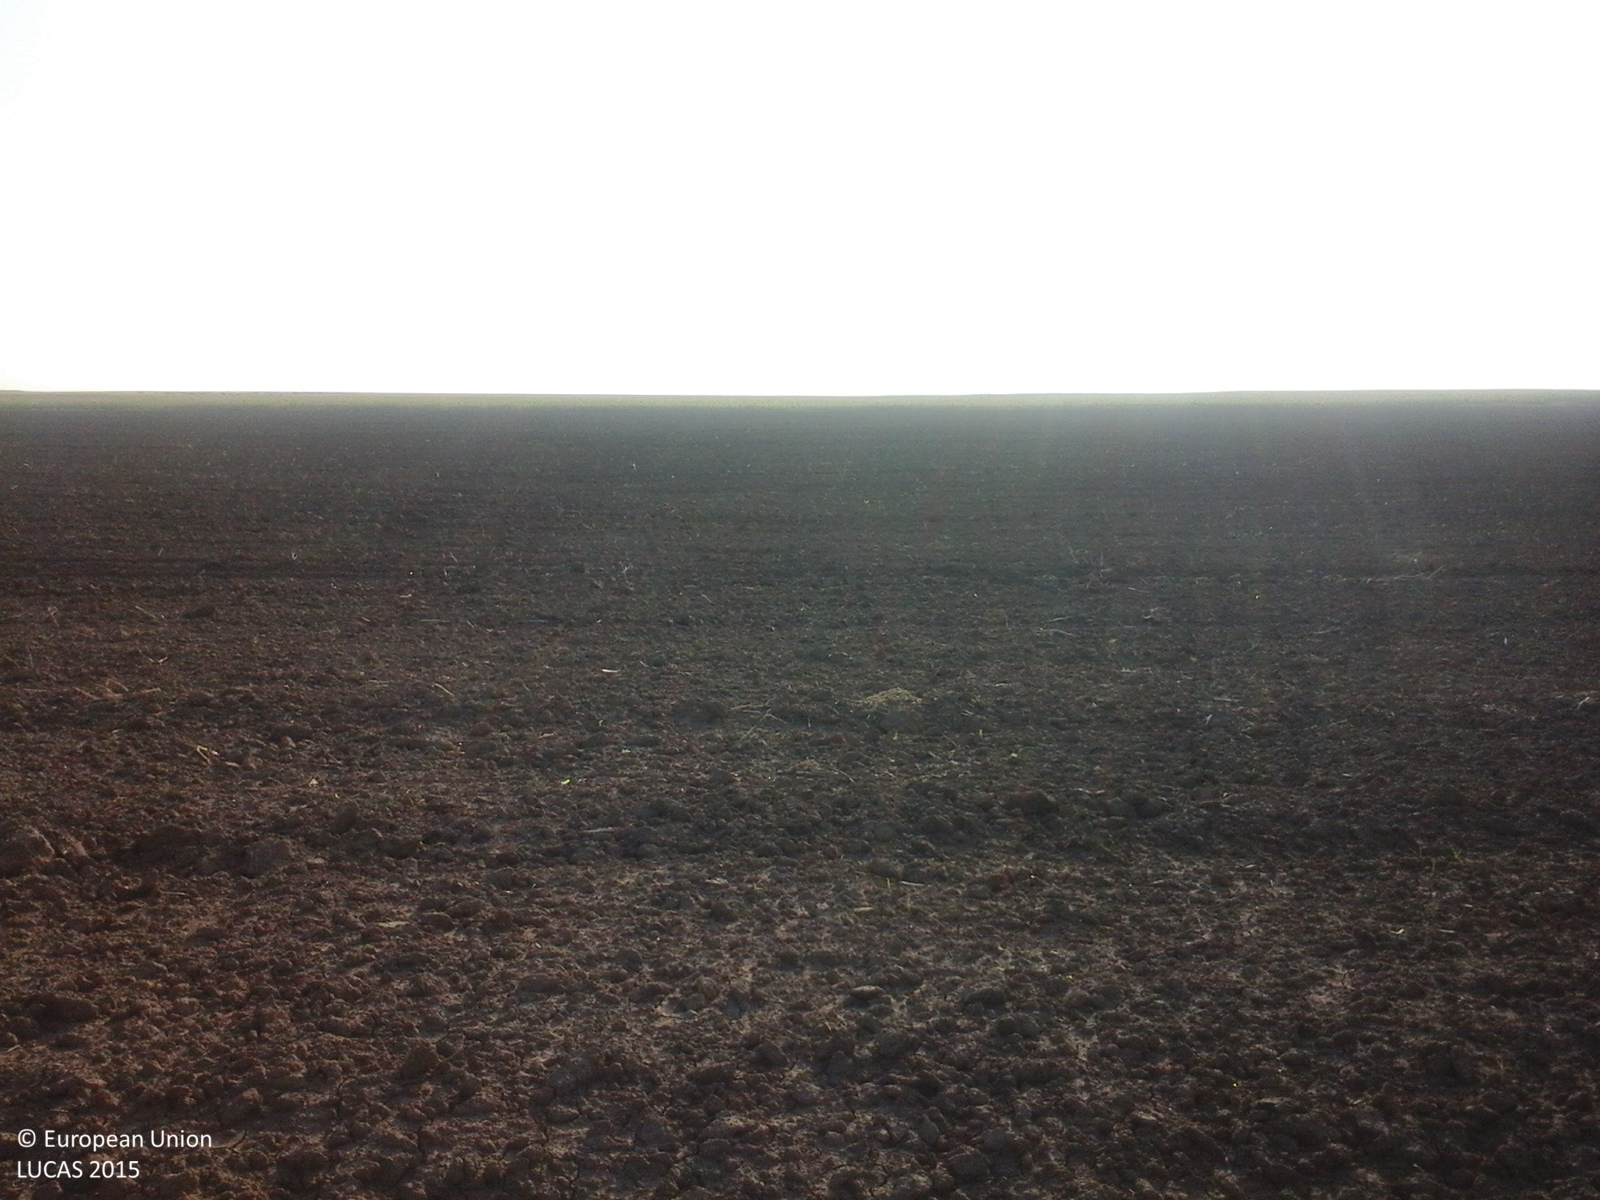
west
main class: Cropland
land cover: Rape and turnip rape
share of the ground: < 10 %
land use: Agriculture (excluding fallow land and kitchen gardens)
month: August
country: RO
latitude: 43.9796
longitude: 28.0940
